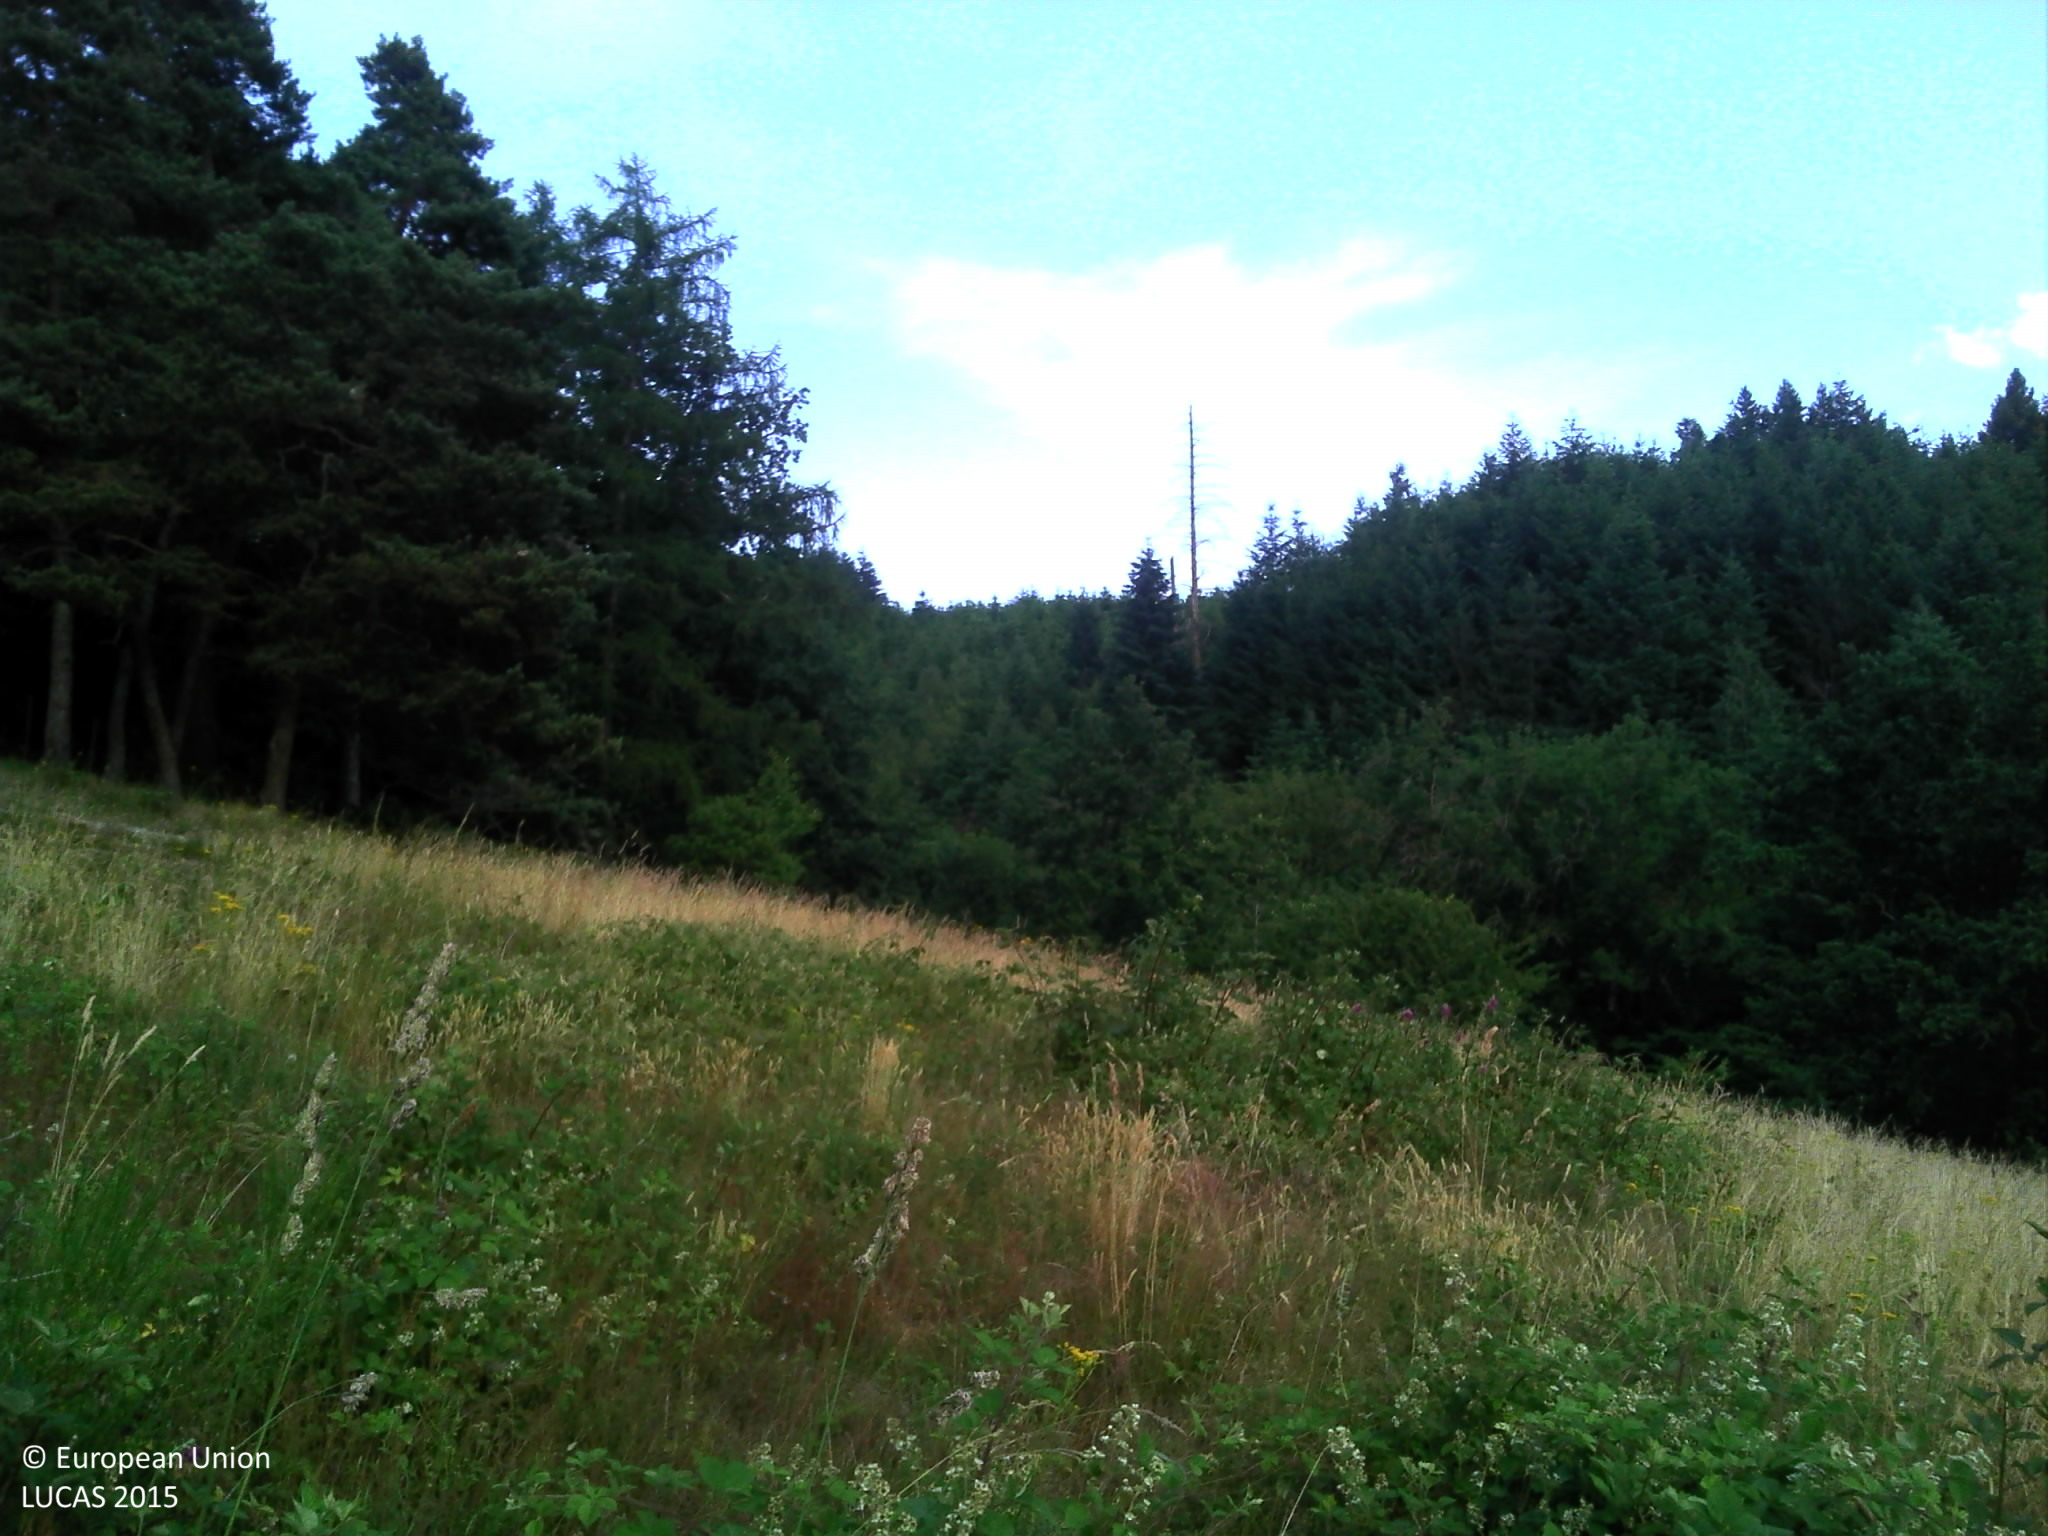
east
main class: Shrubland
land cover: Shrubland without tree cover
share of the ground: > 75 %
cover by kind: herbaceous plants 75 %, shrubs 25 %
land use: Agriculture (excluding fallow land and kitchen gardens)
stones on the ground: 10 - 25 %
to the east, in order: Shrubland without tree cover; Broadleaved woodland; Grassland without tree/shrub cover; Fences; Spruce dominated mixed woodland; Shrubland with sparse tree cover; Tracks; Shrubland with sparse tree cover
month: June
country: FR
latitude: 46.3544
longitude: 4.5045
